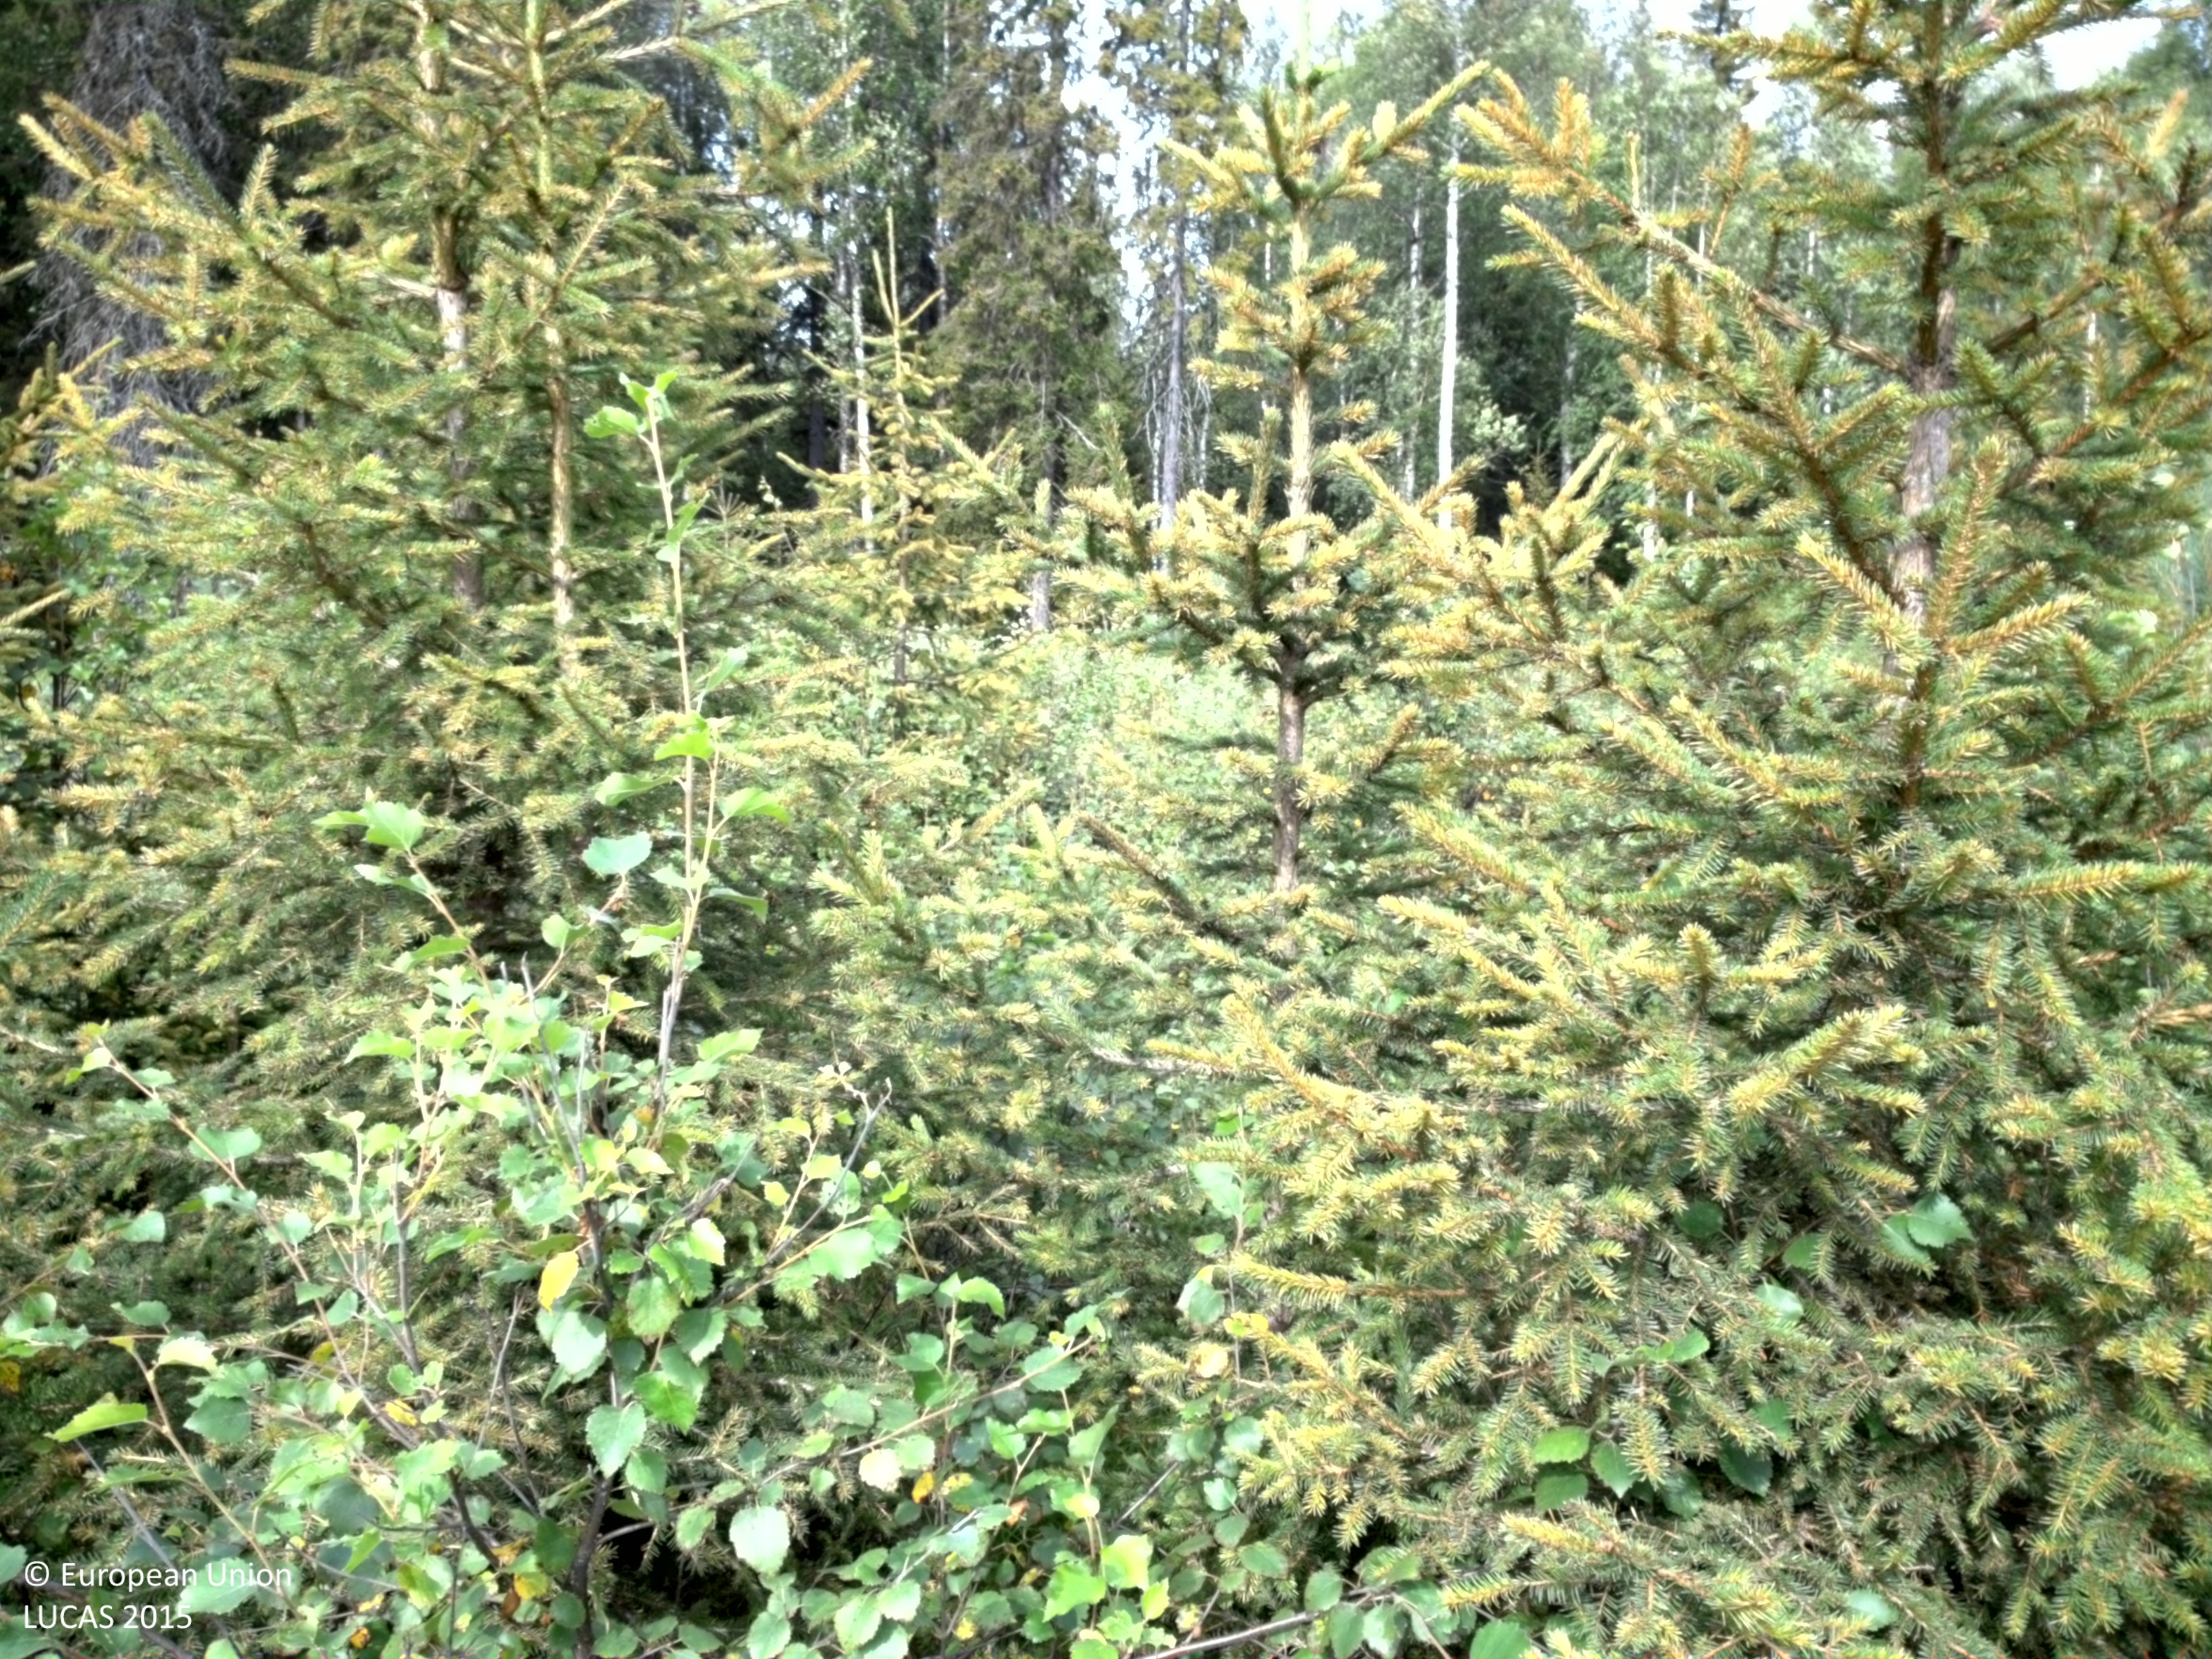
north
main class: Woodland
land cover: Other mixed woodland
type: boreal forest
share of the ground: 50 - 75 %
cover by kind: broadleaved forest trees 35 %, shrubs 35 %, coniferous forest trees 15 %, herbaceous plants 15 %
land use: Forestry
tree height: < 5 m
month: August
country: SE
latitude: 65.9830
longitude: 22.6408
